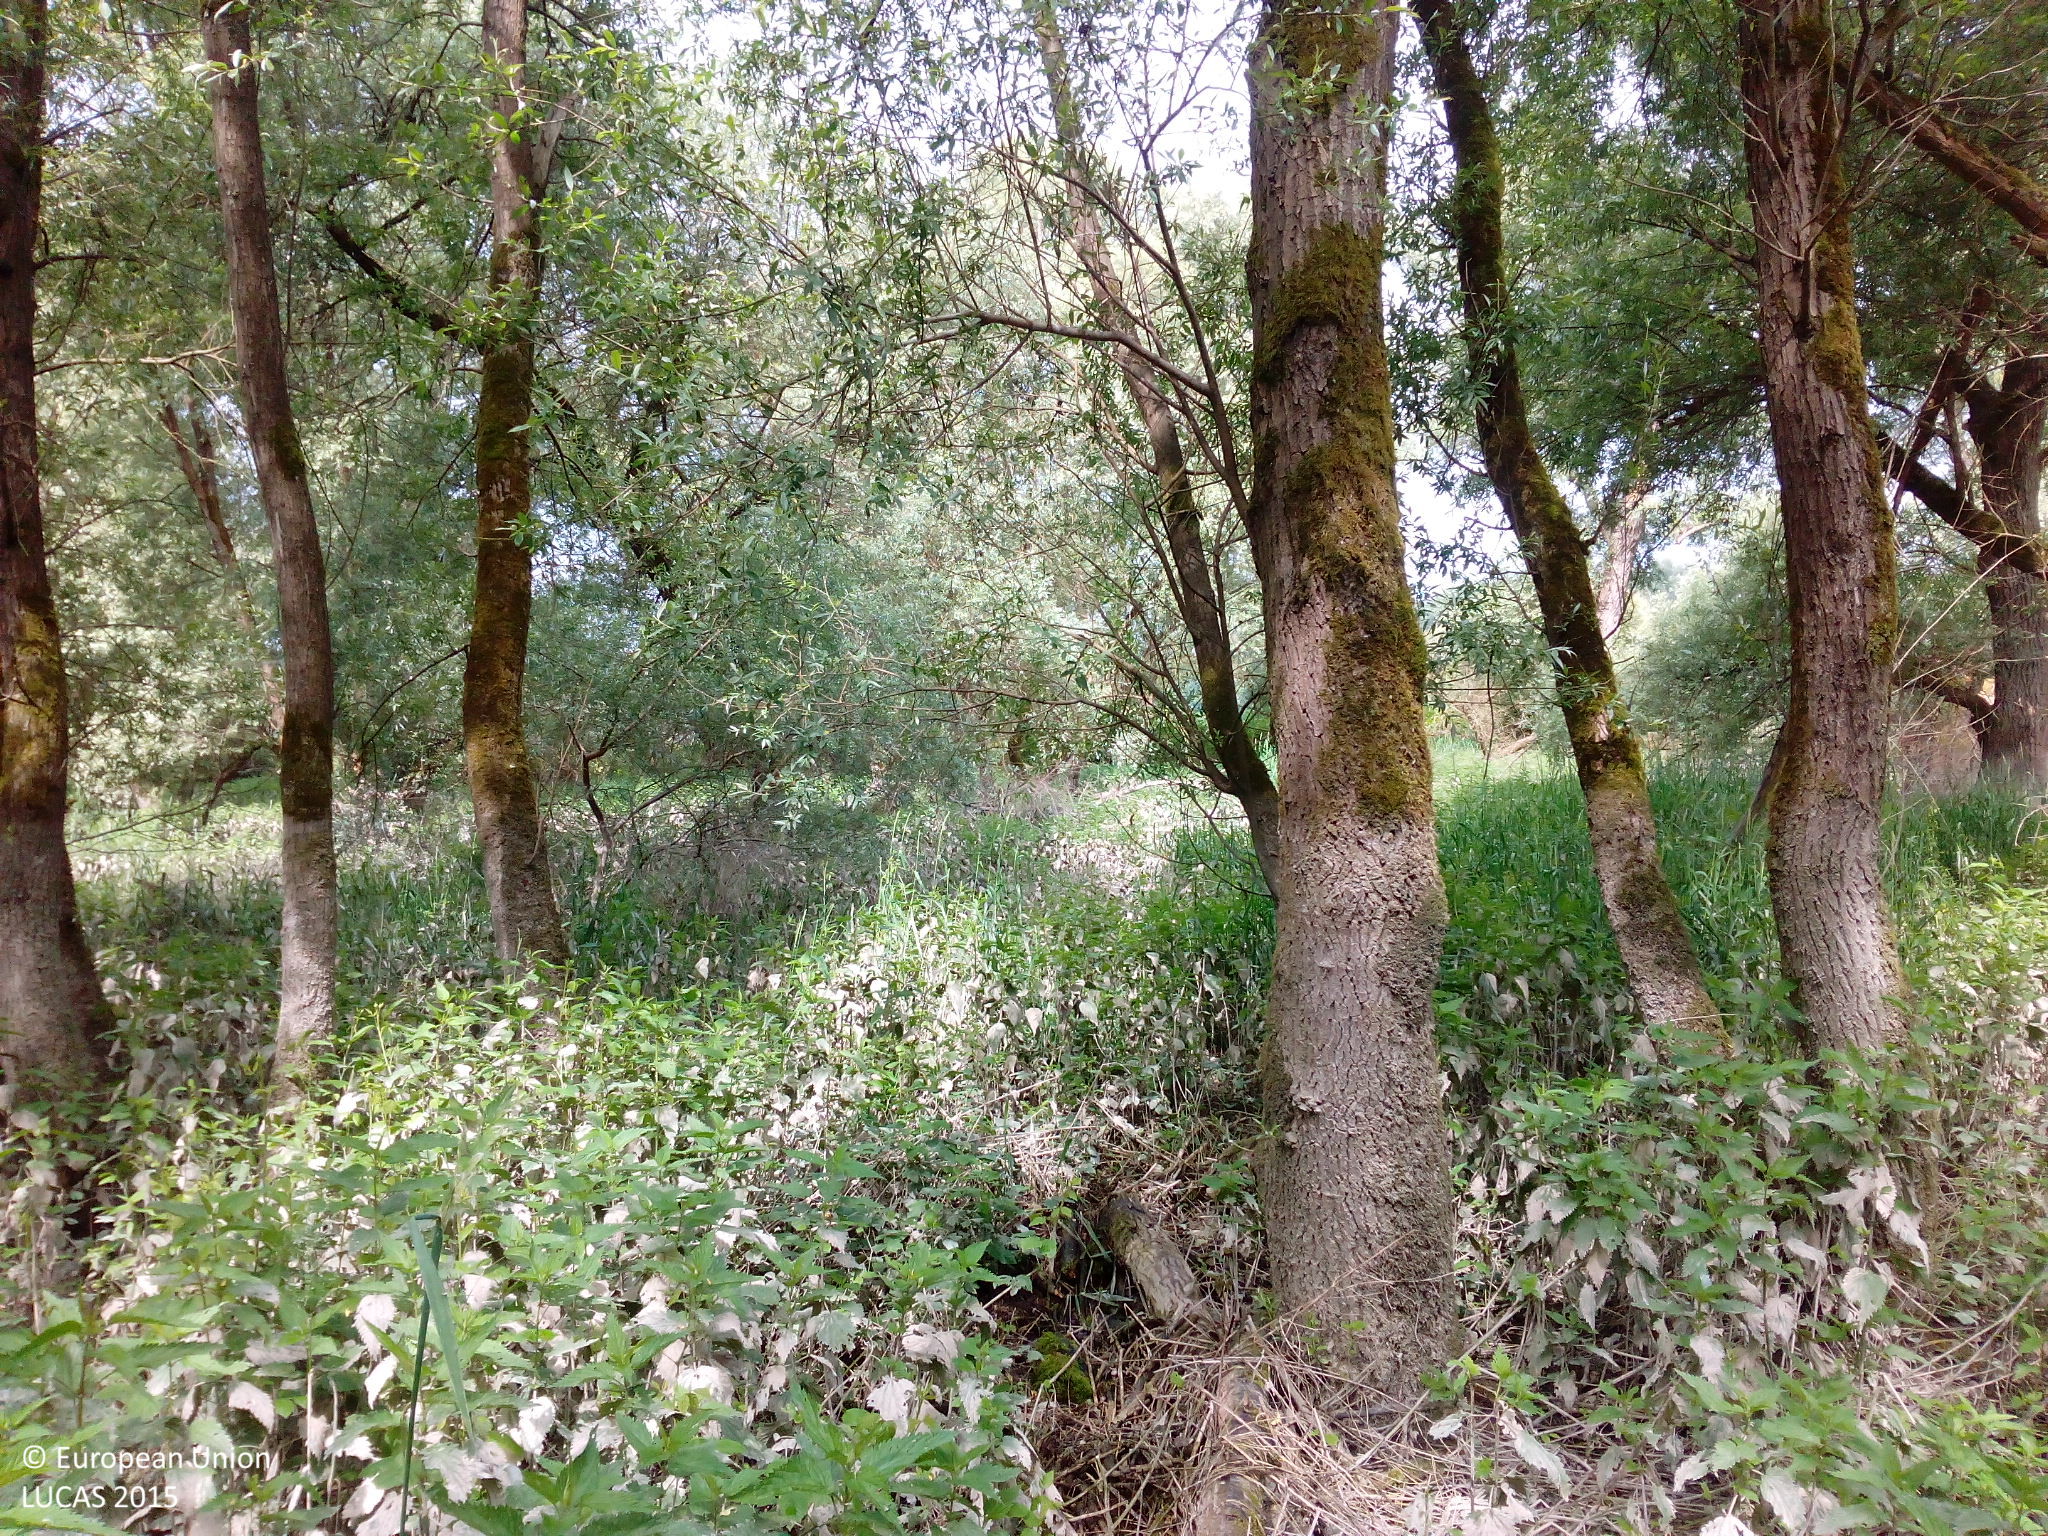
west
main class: Woodland
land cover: Broadleaved woodland
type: floodplain forest
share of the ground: 25 - 50 %
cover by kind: broadleaved forest trees 60 %, herbaceous plants 20 %, unconsolidated bare surface 20 %
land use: Semi-natural and natural areas not in use
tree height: > 5 m
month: May
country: DE
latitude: 48.9100
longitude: 8.1587
